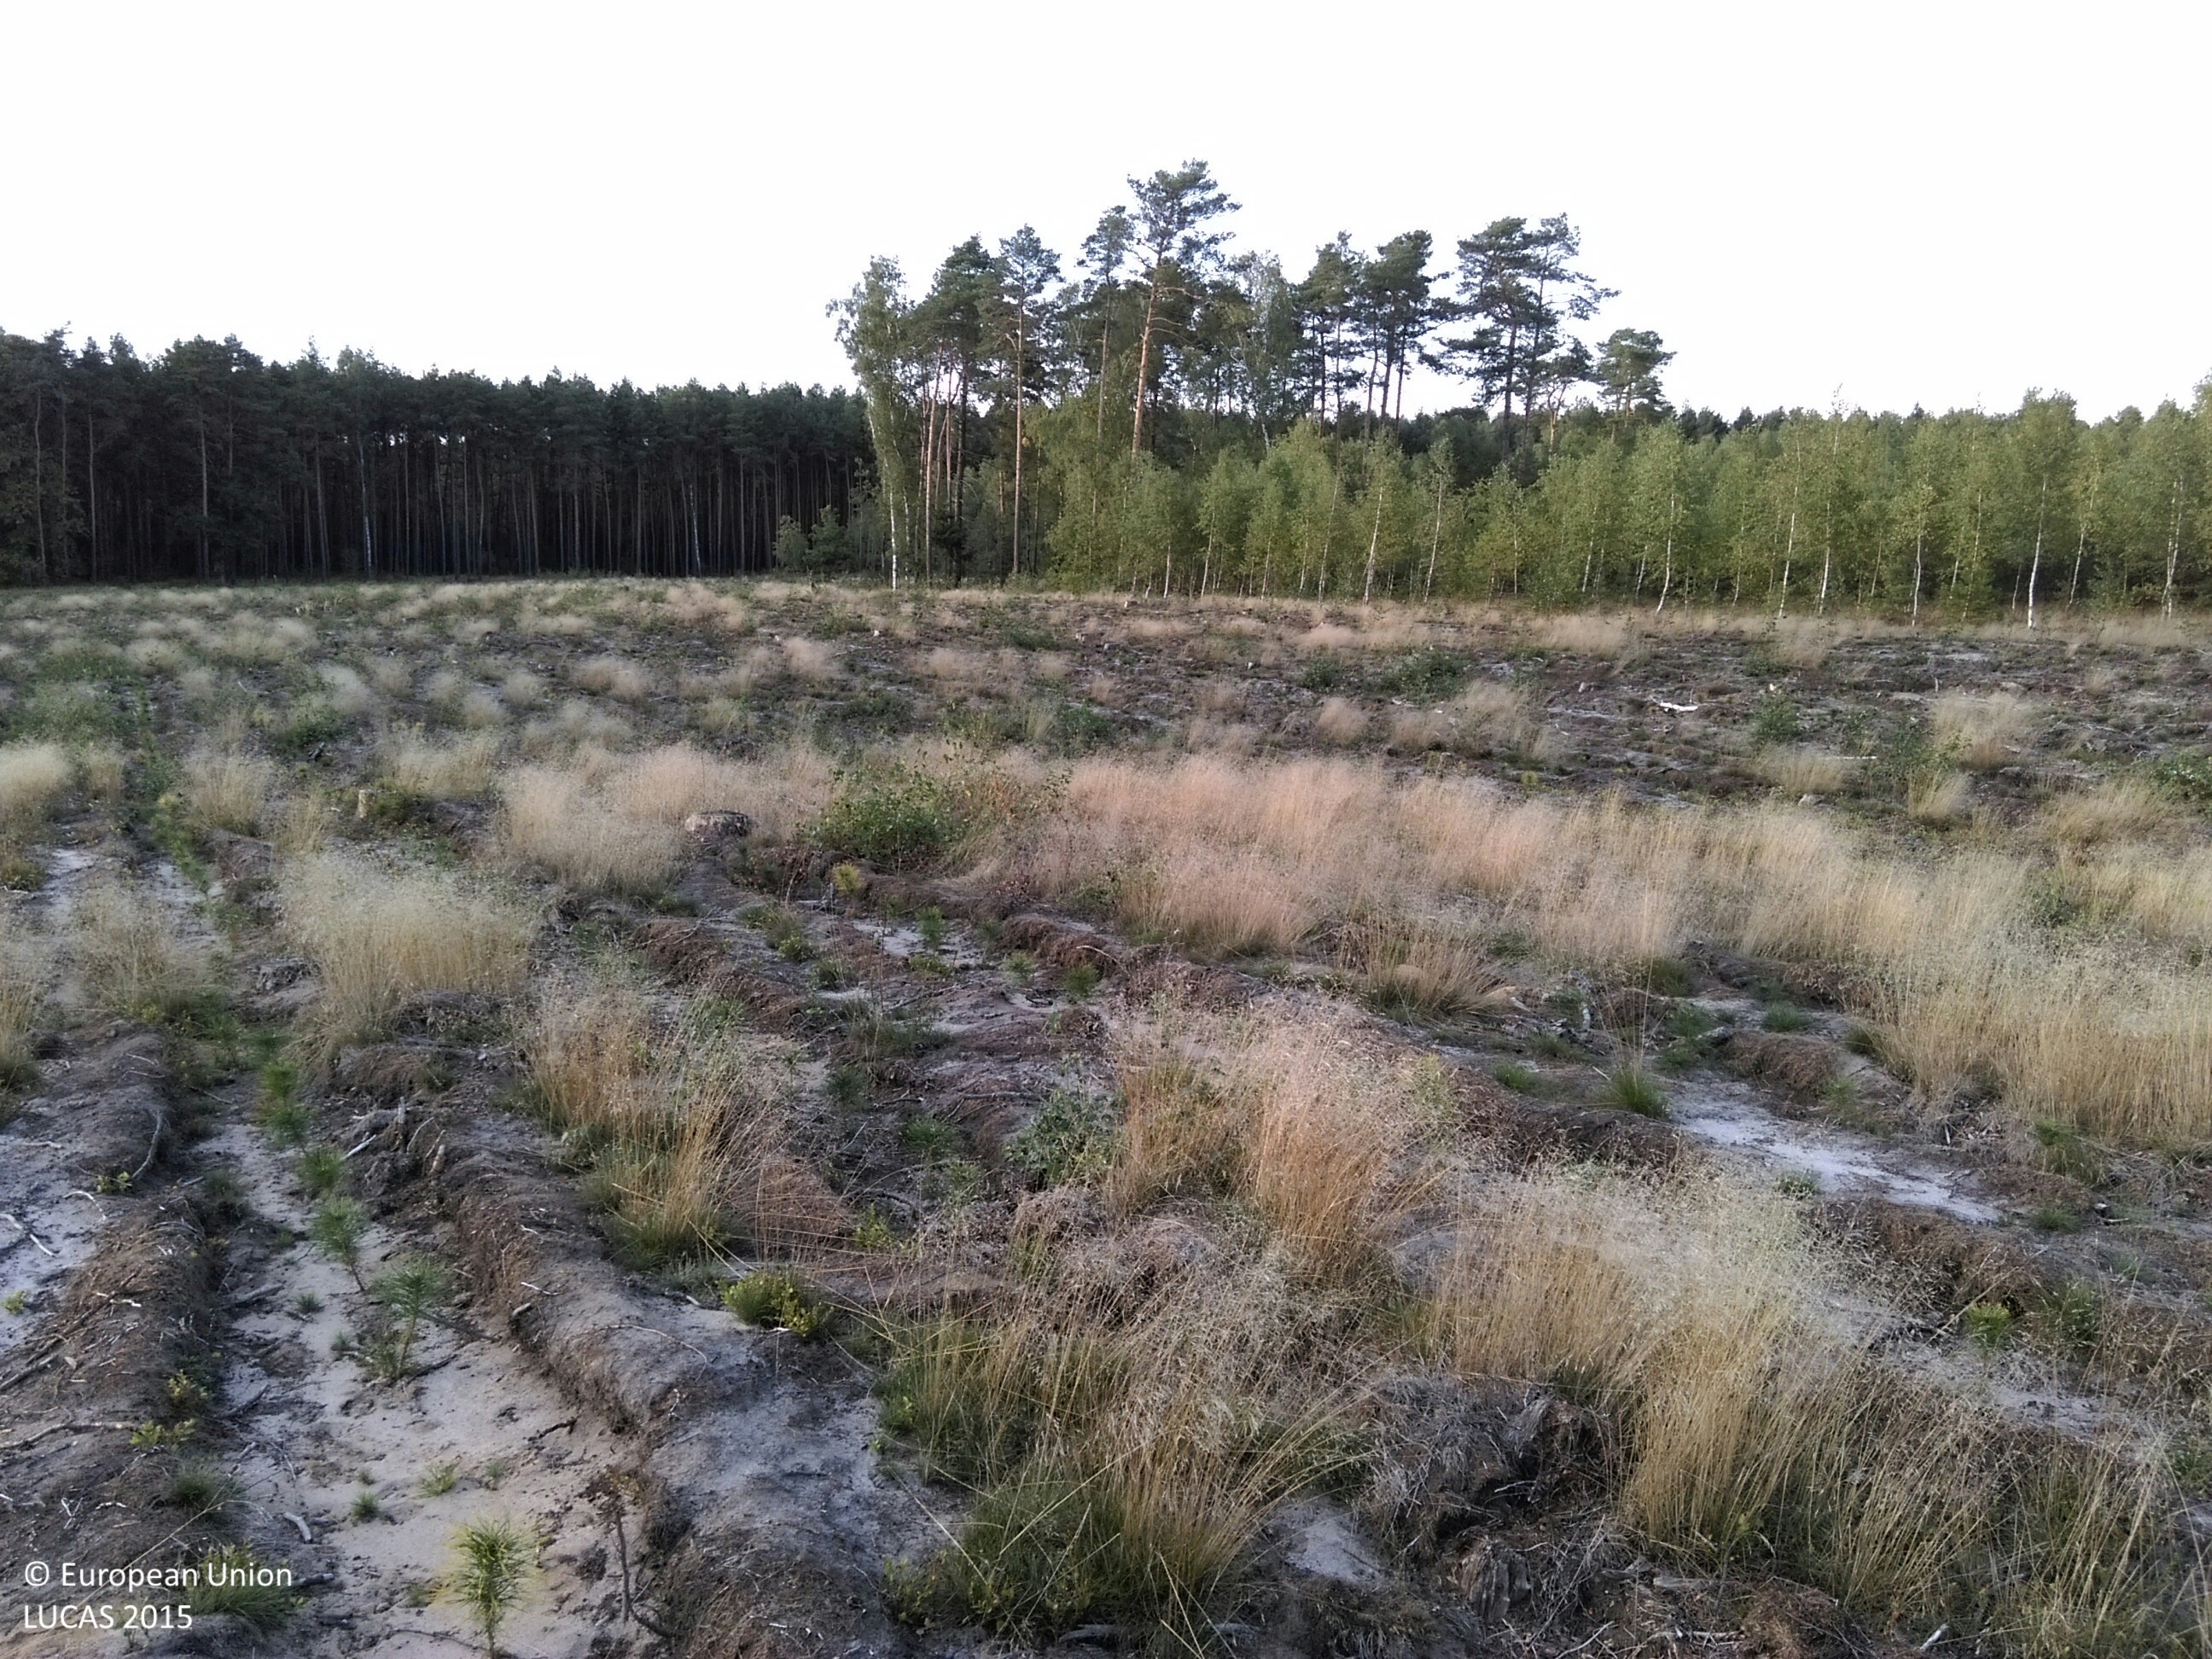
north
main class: Woodland
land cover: Pine dominated coniferous woodland
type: hemiboreal forest and nemoral coniferous forest and mixed broadleaved-coniferous forest
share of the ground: 10 - 25 %
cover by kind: herbaceous plants 50 %, unconsolidated bare surface 30 %, coniferous forest trees 20 %
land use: Forestry
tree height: < 5 m
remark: Clear cut
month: September
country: PL
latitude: 52.1588
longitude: 16.2484
